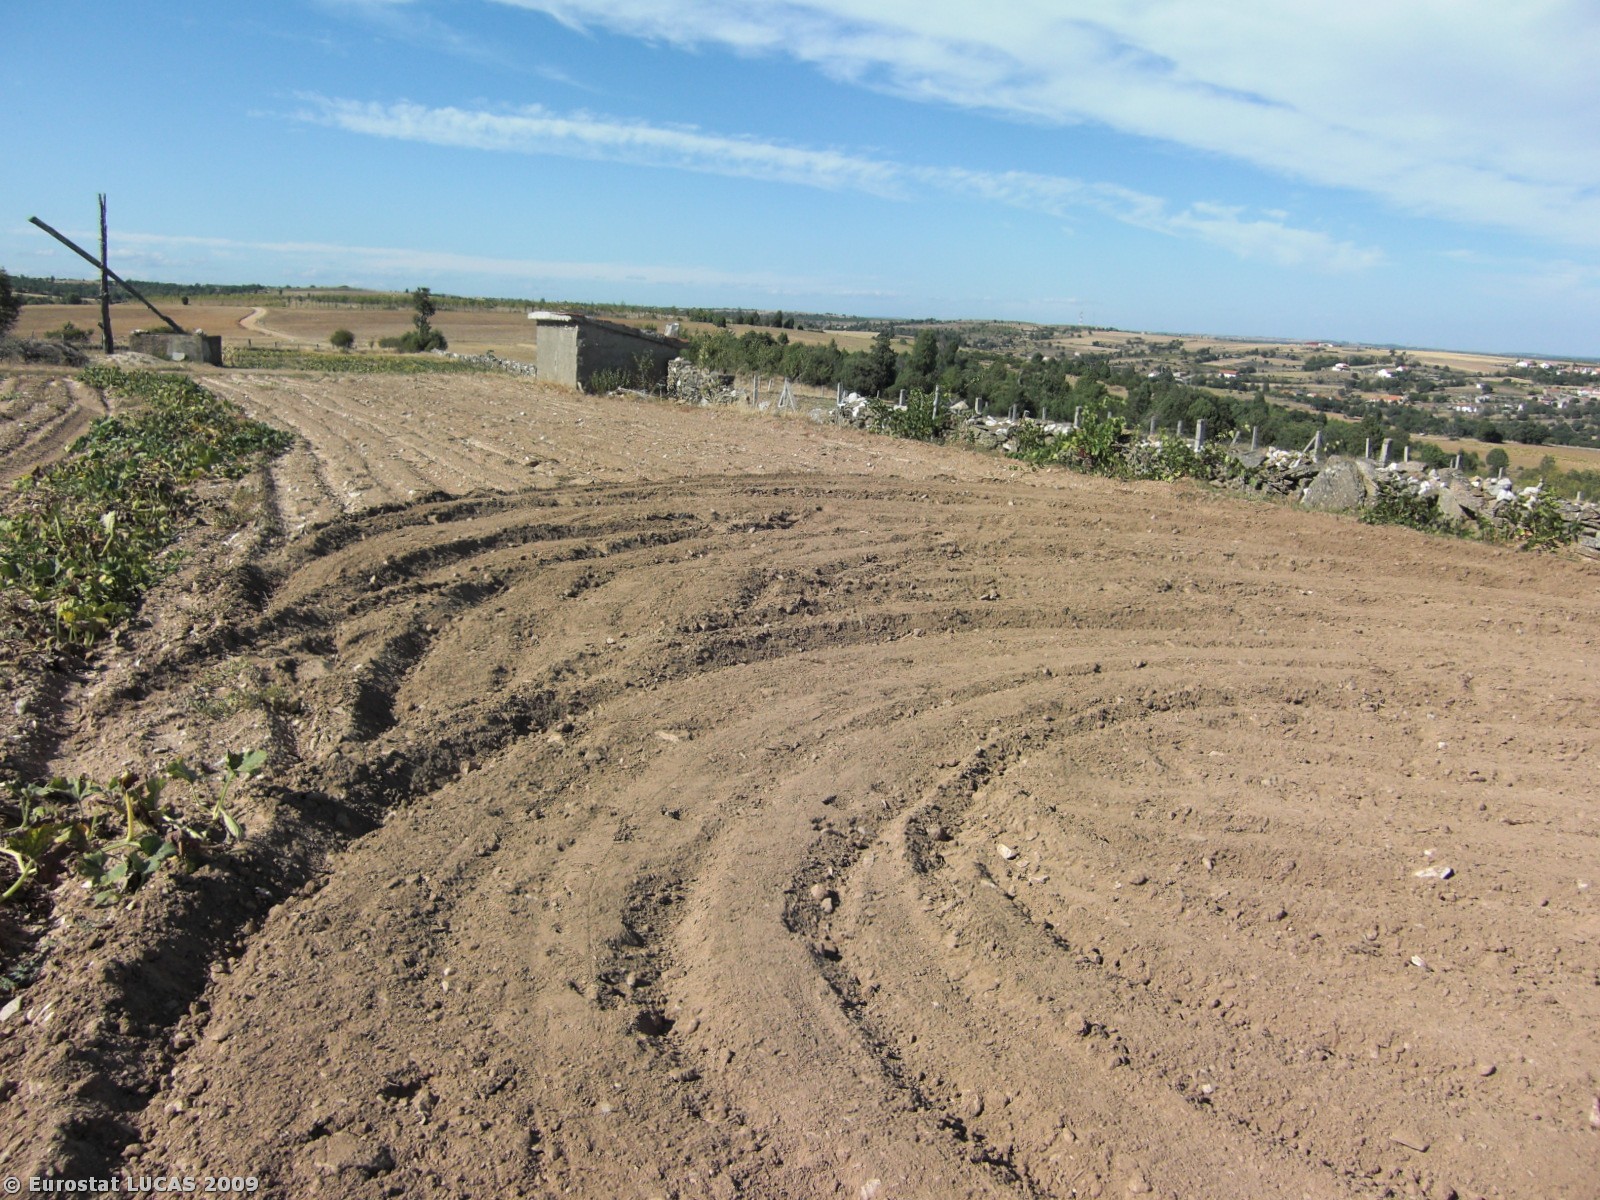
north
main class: Cropland
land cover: Other fresh vegetables
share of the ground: 10 - 25 %
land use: Agriculture (excluding fallow land and kitchen gardens)
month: August
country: PT
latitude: 41.4667
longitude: -6.3221
